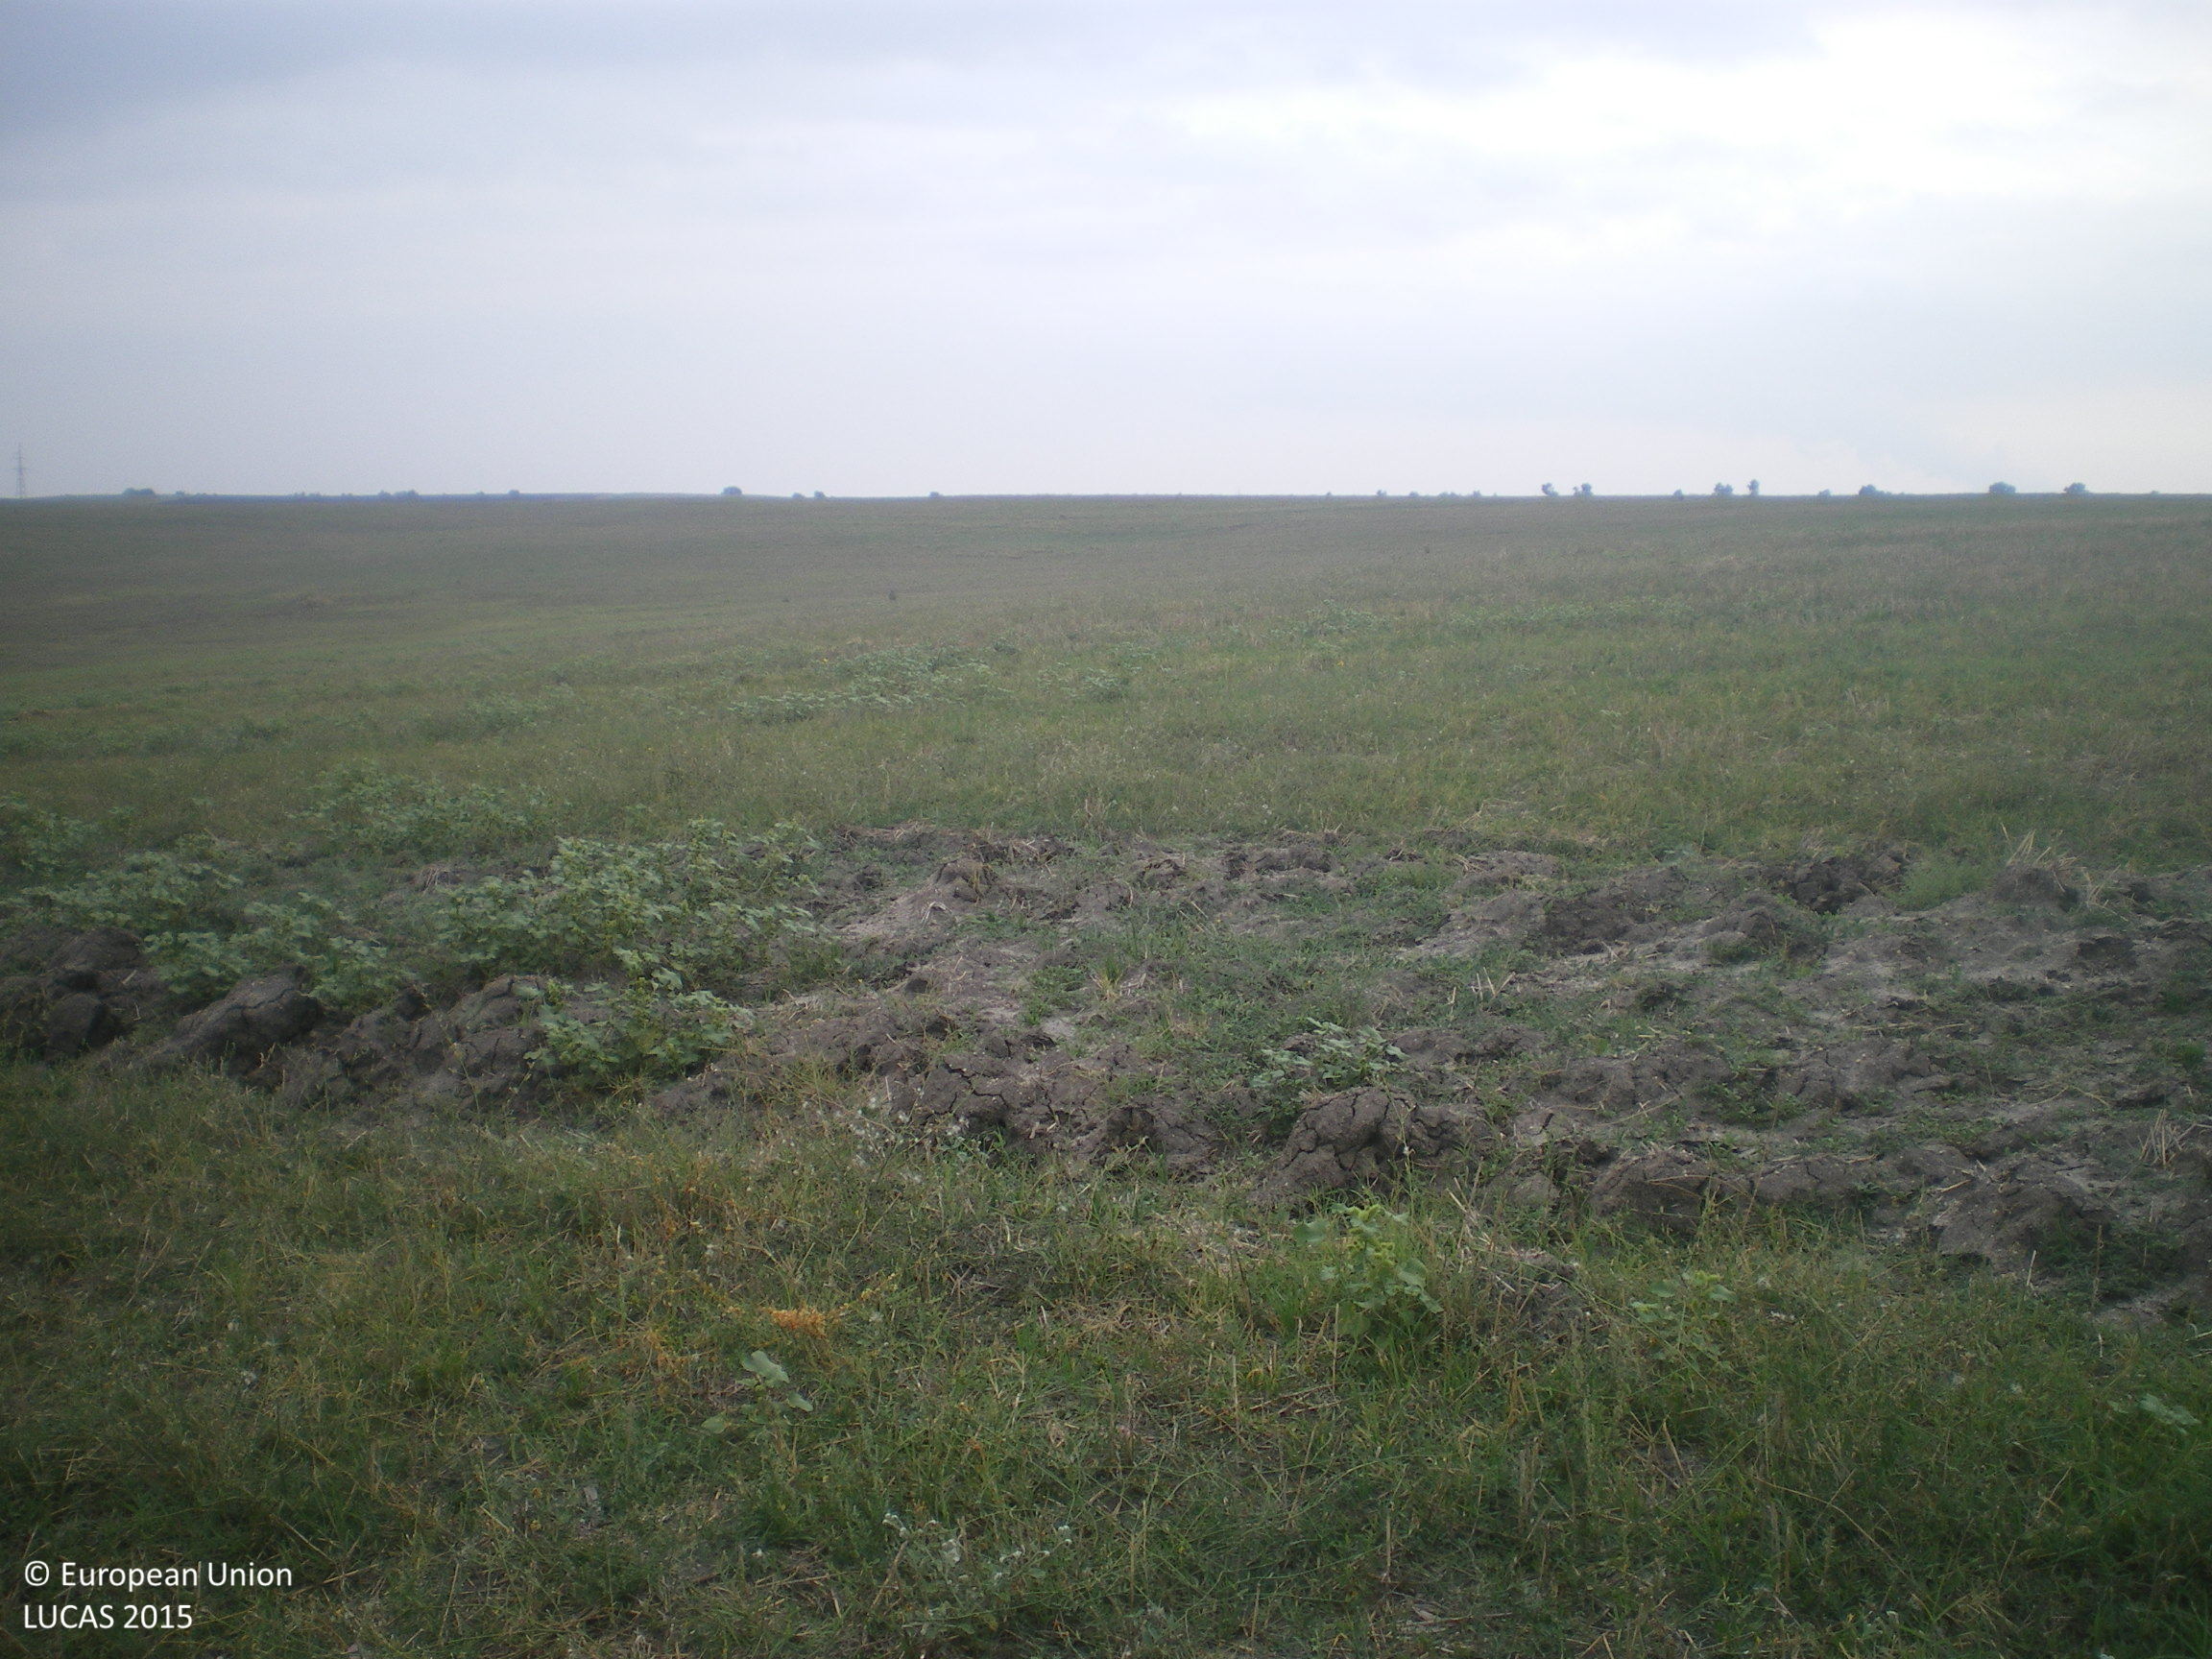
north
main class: Cropland
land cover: Barley
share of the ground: < 10 %
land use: Agriculture (excluding fallow land and kitchen gardens)
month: September
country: BG
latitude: 42.0456
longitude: 25.8131
